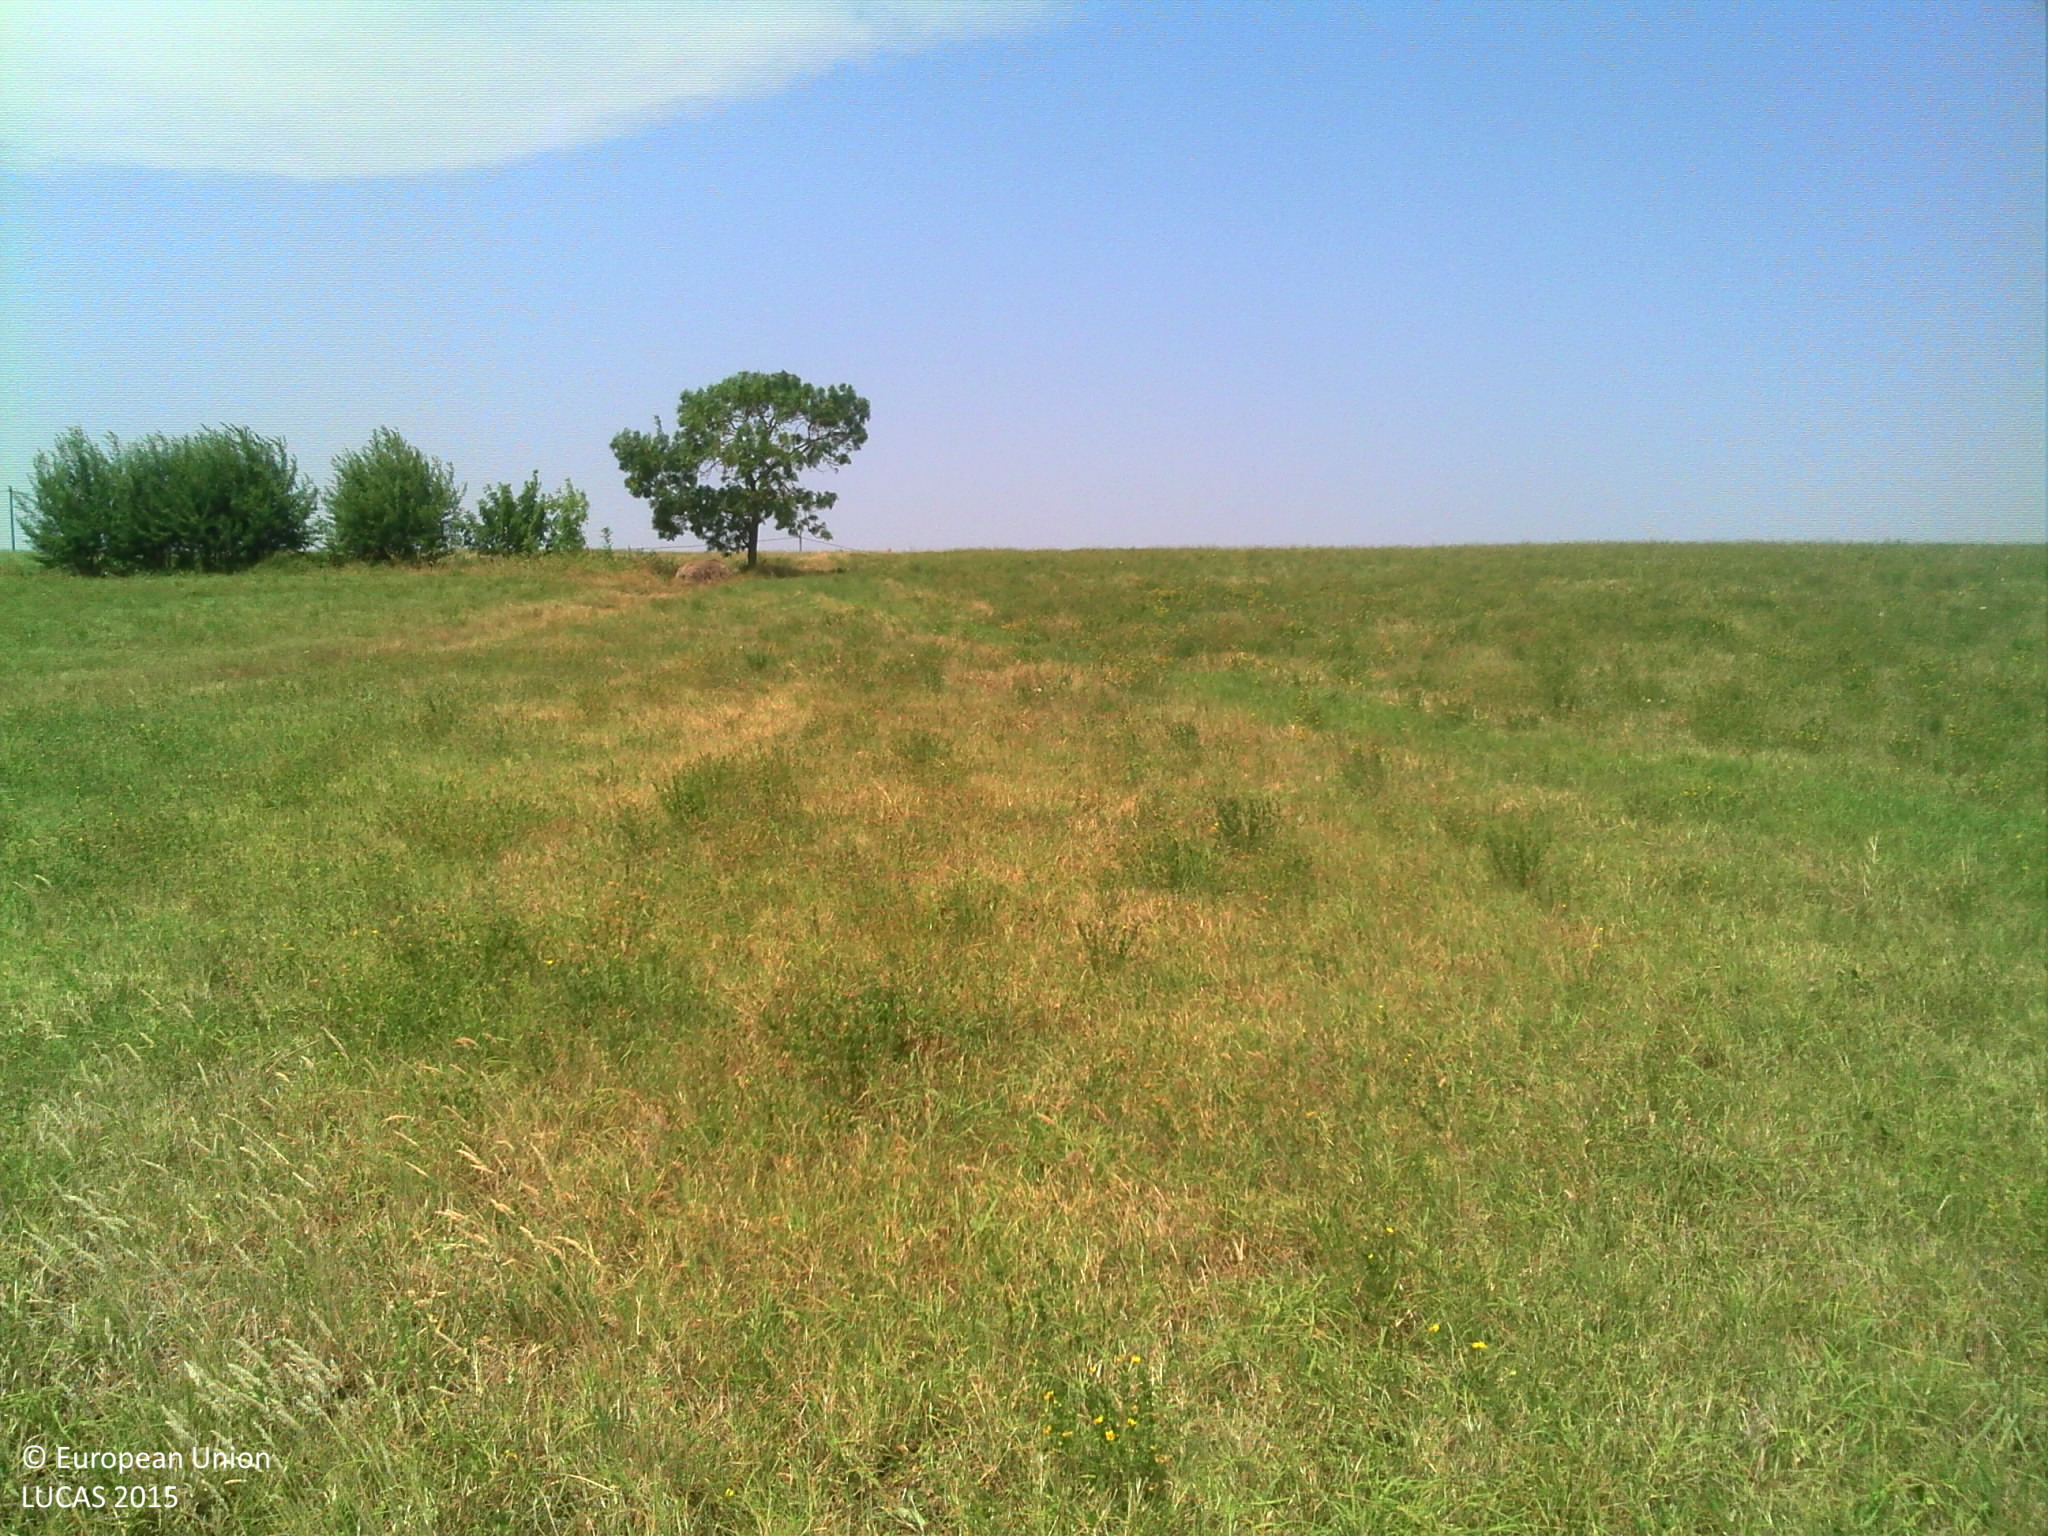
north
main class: Grassland
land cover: Grassland without tree/shrub cover
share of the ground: > 75 %
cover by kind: herbaceous plants 100 %
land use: Agriculture (excluding fallow land and kitchen gardens)
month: July
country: FR
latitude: 43.3113
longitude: 1.0638
